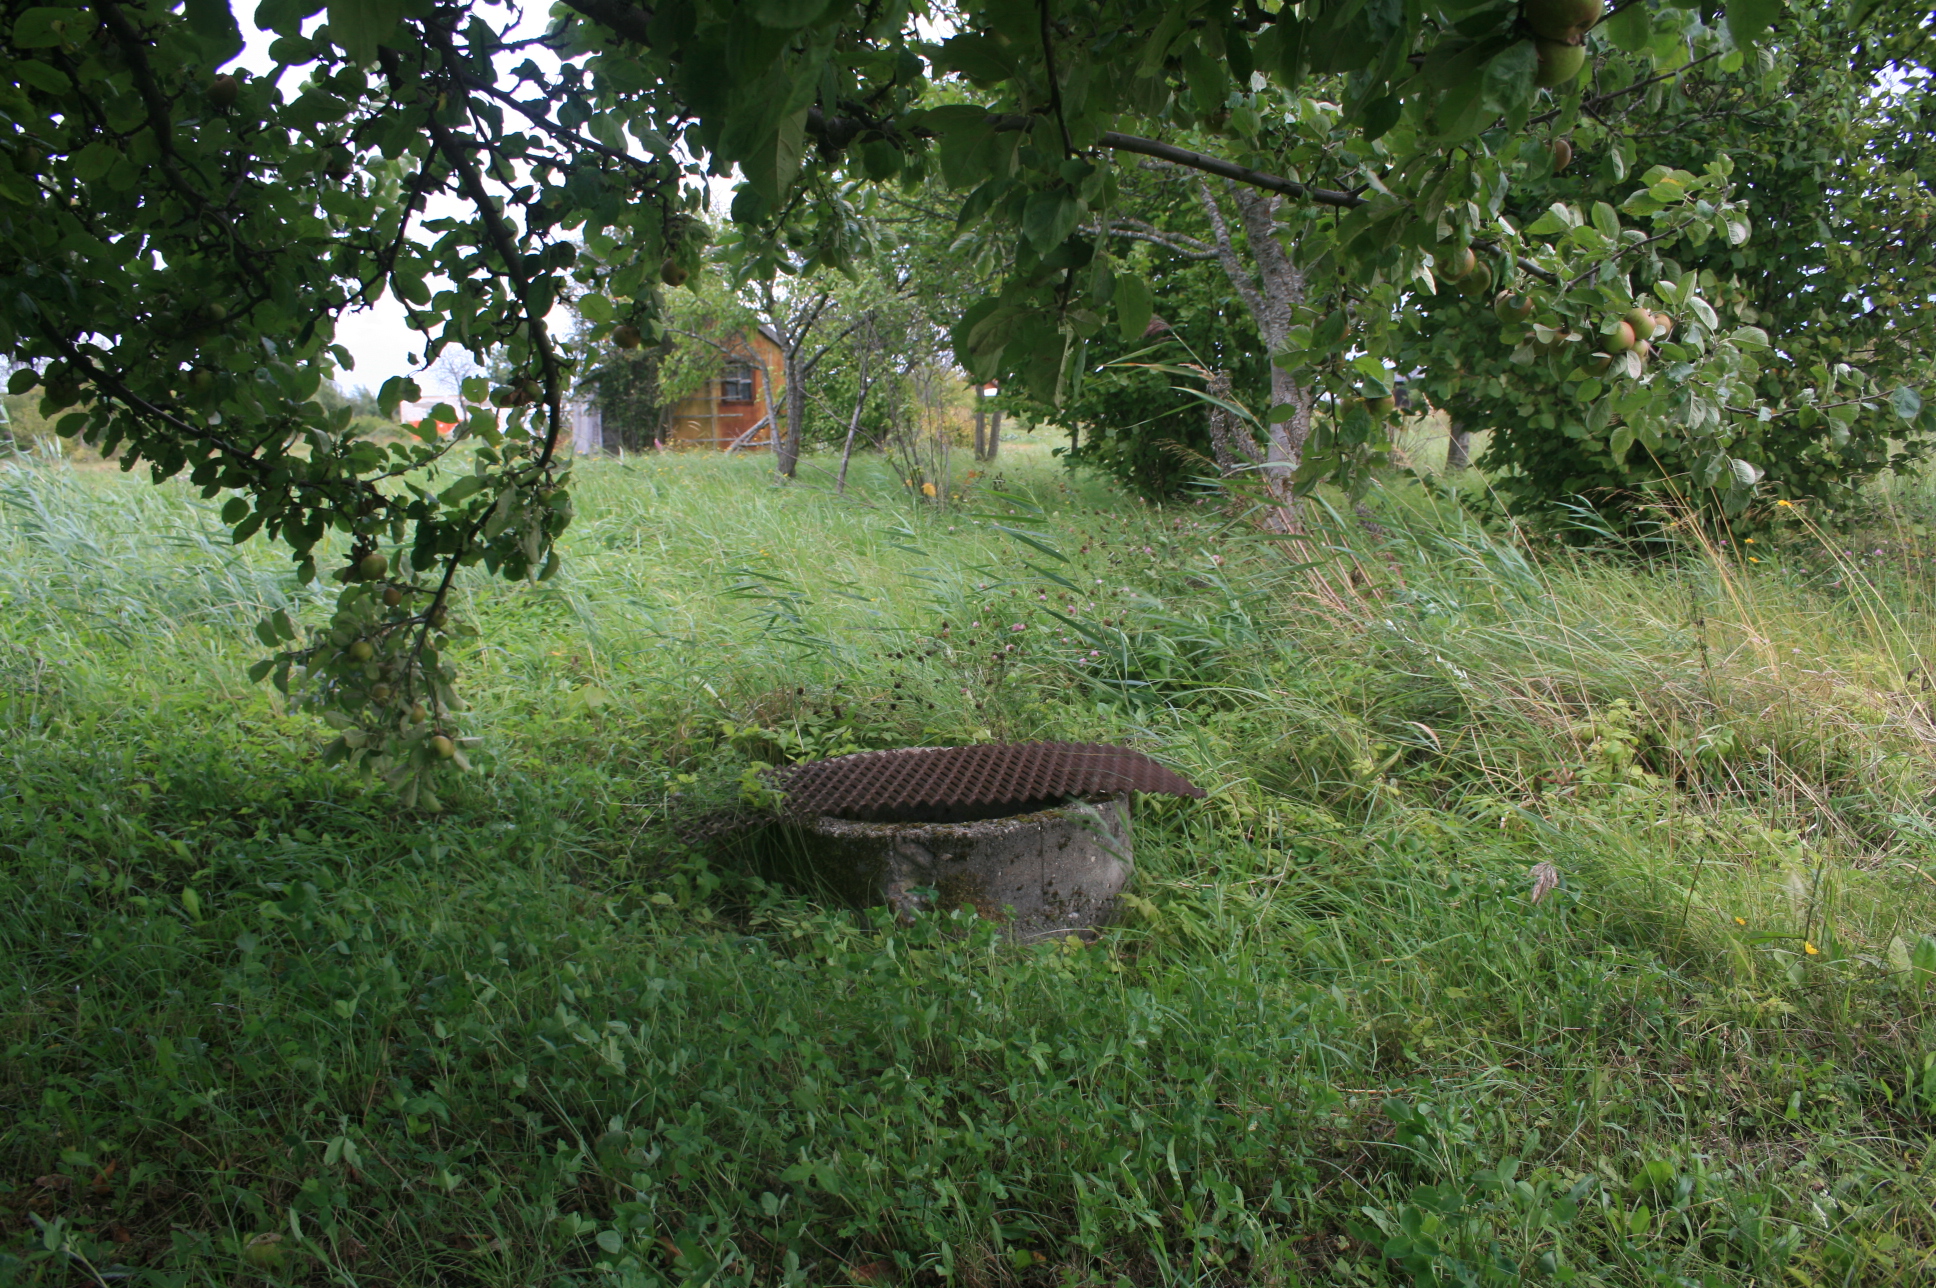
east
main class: Cropland
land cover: Apple fruit
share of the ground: 50 - 75 %
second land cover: Grassland without tree/shrub cover
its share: > 75 %
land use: Kitchen garden
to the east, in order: Apple fruit; Grassland without tree/shrub cover; Artificial constructions in urban areas
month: September
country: LT
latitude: 55.7028
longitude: 21.3249
